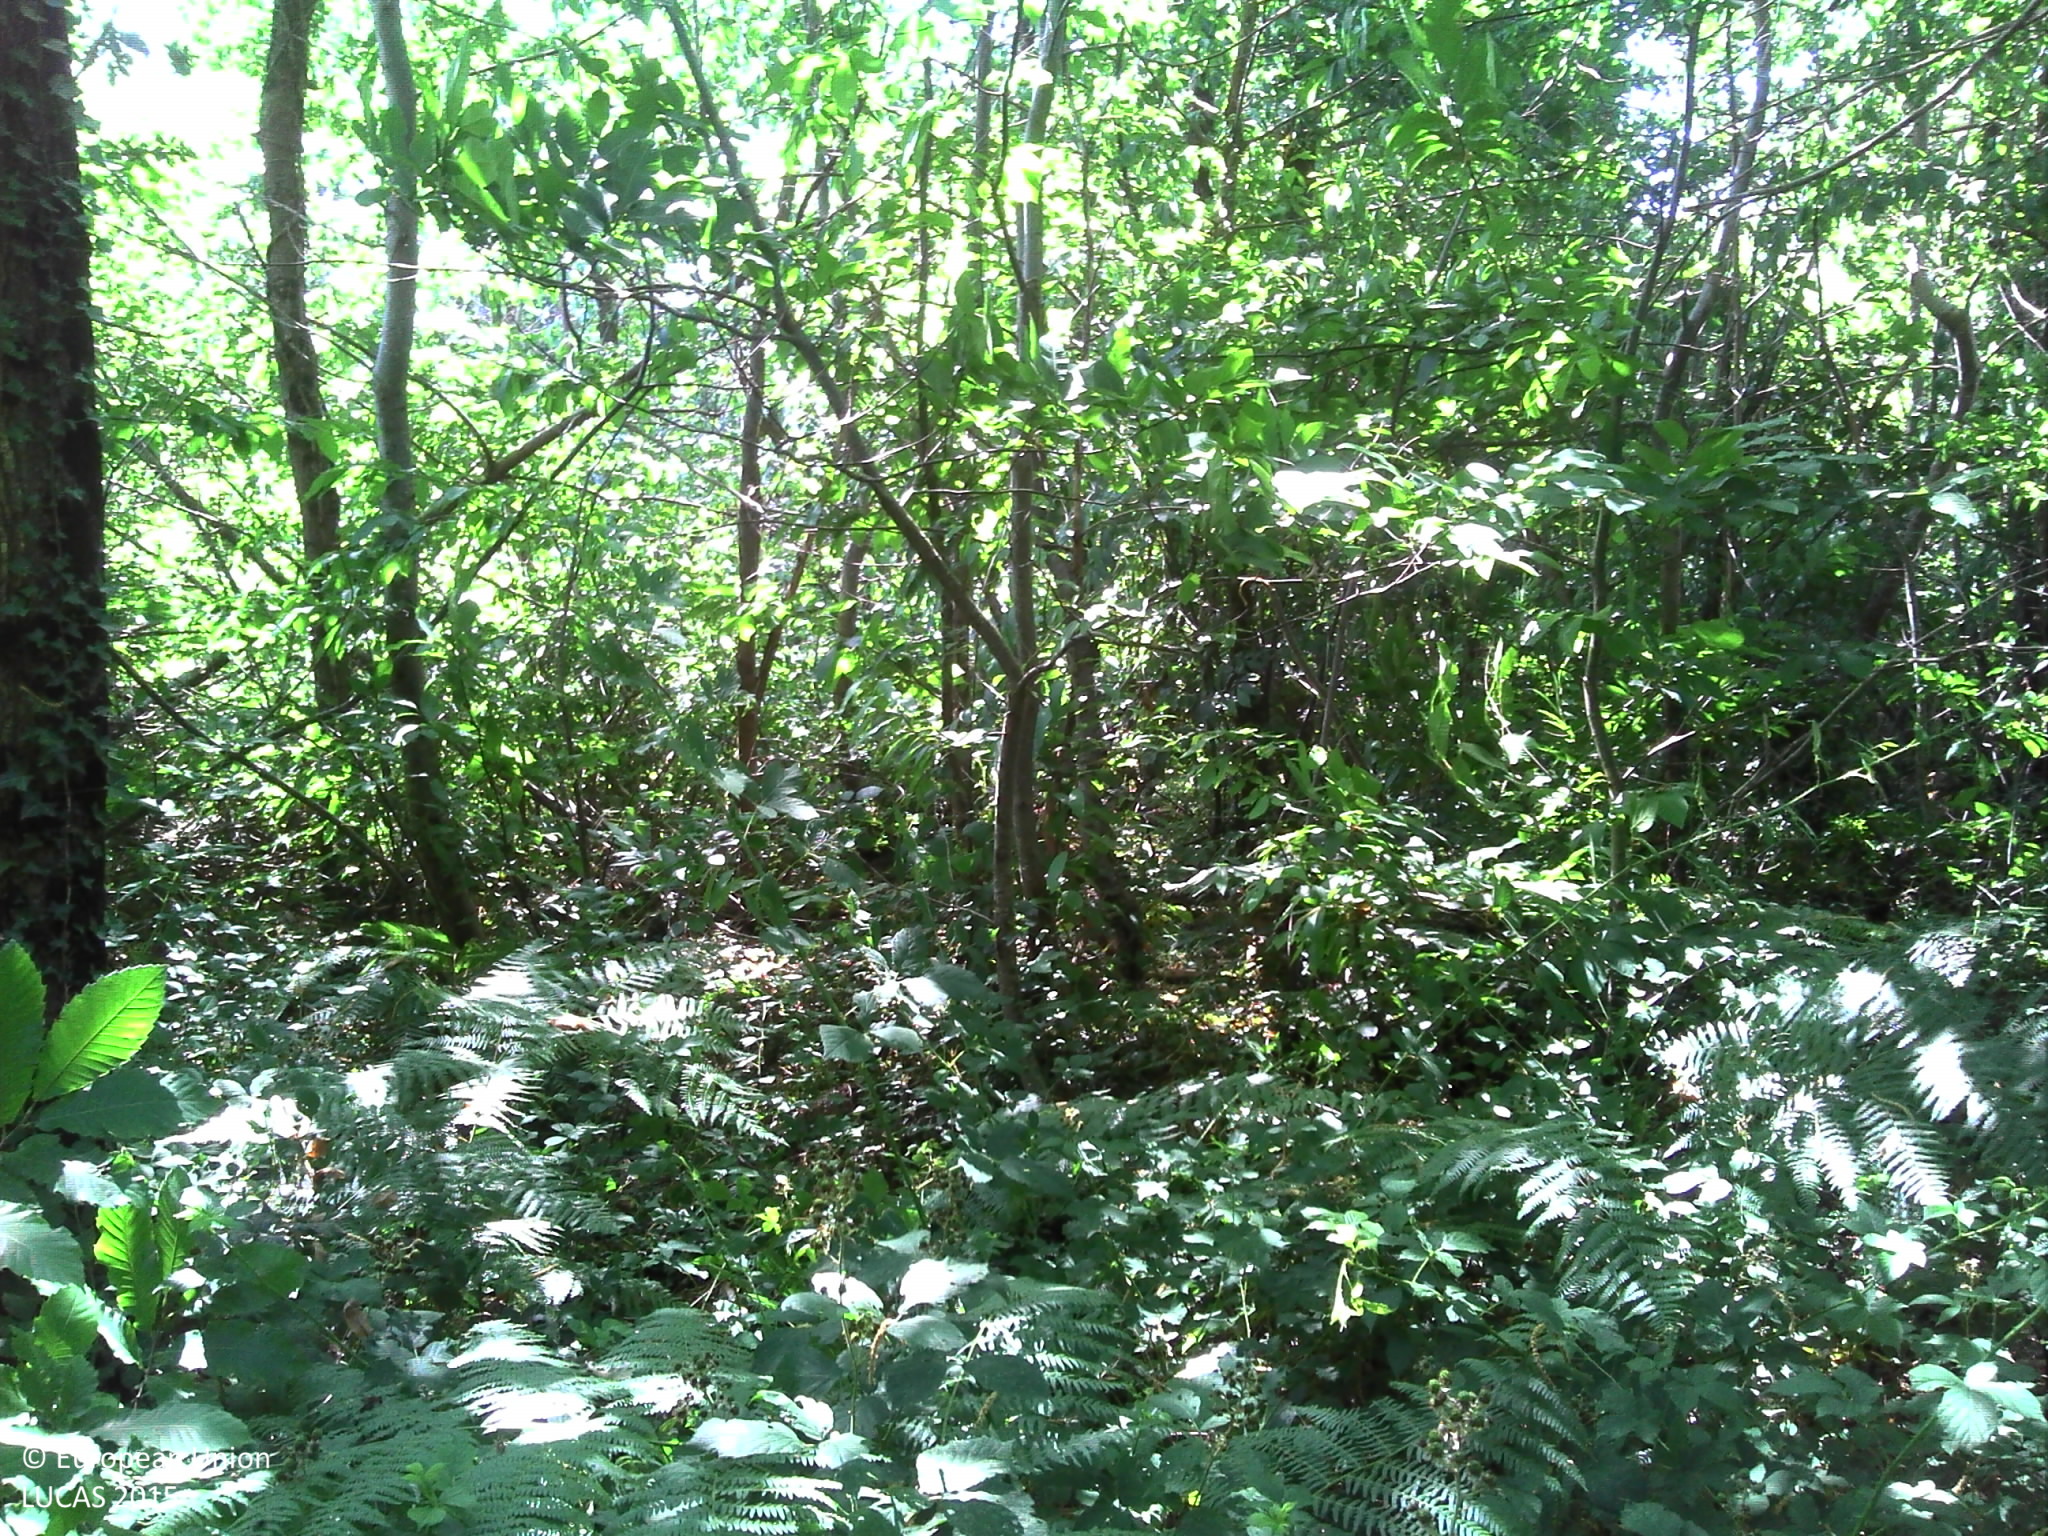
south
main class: Woodland
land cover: Broadleaved woodland
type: non-riverine alder, birch or aspen forest
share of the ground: > 75 %
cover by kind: broadleaved forest trees 95 %, herbaceous plants 5 %
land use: Semi-natural and natural areas not in use
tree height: > 5 m
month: July
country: FR
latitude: 47.6363
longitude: -2.0158
